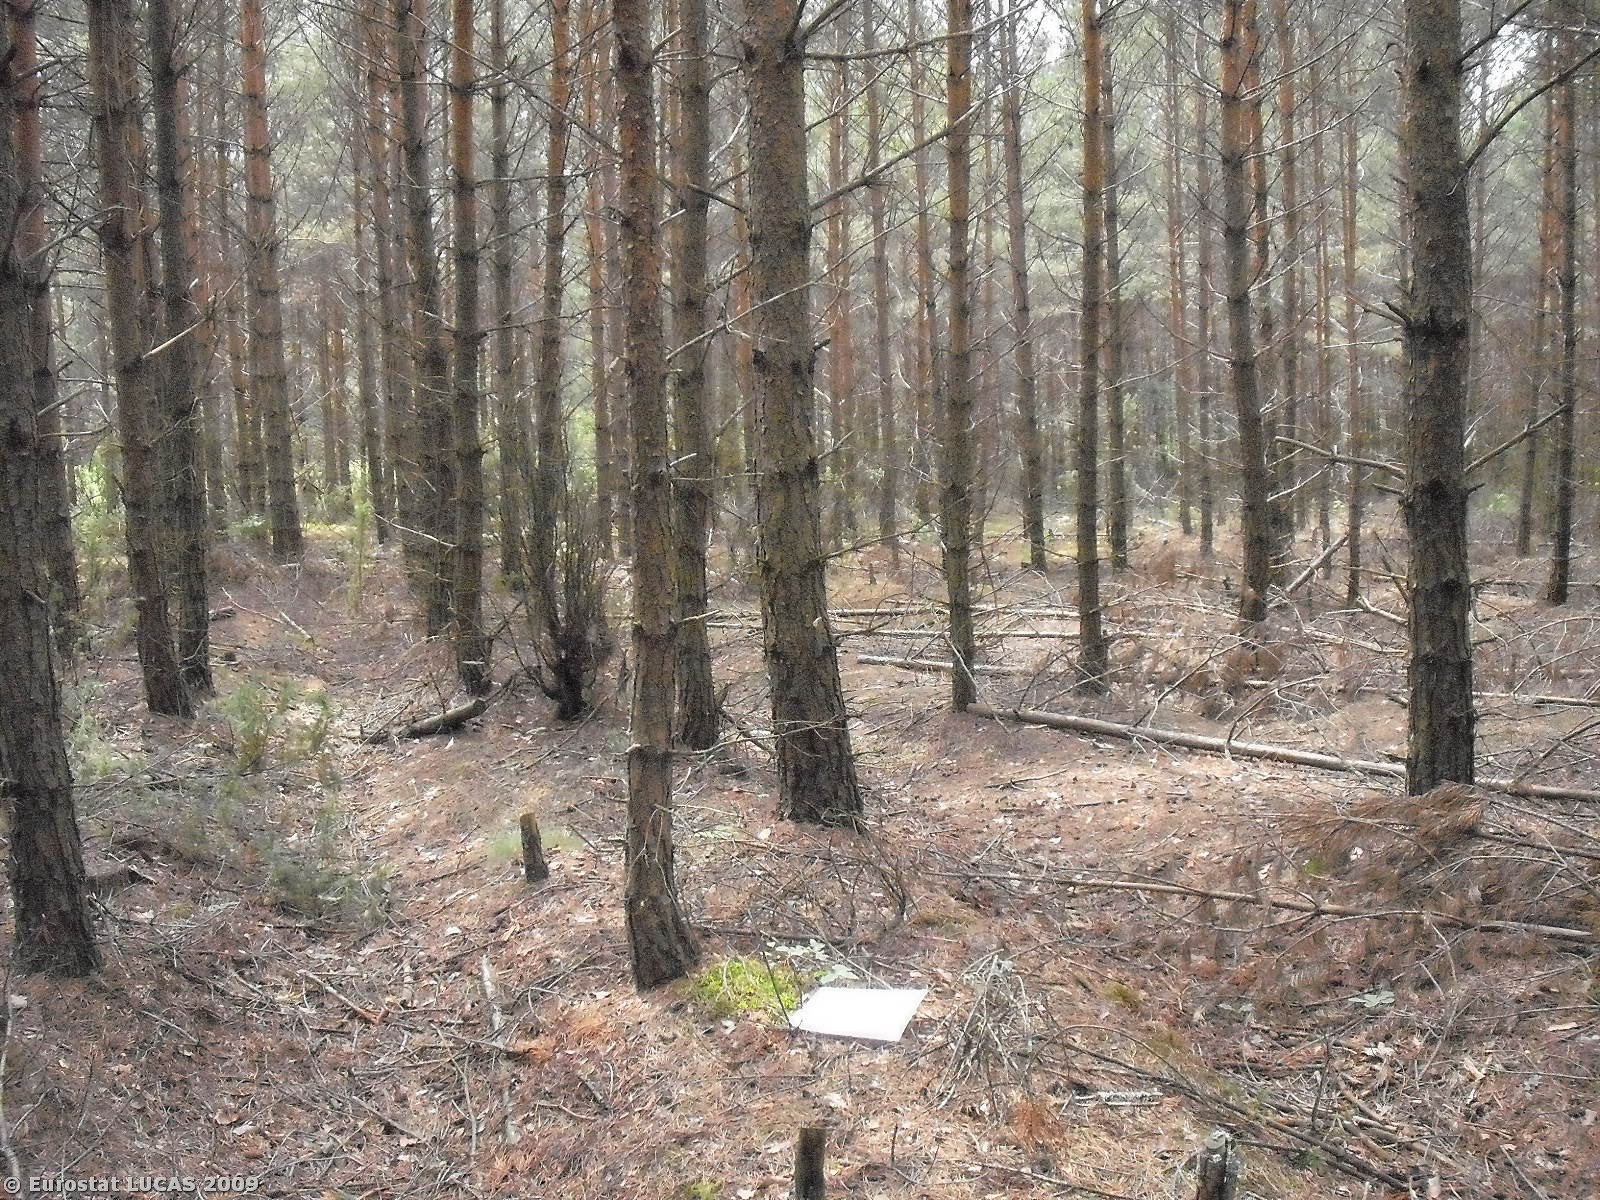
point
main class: Woodland
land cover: Coniferous woodland
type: hemiboreal forest and nemoral coniferous forest and mixed broadleaved-coniferous forest
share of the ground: > 75 %
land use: Forestry
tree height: > 5 m
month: June
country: PL
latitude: 51.2387
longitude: 20.5090
